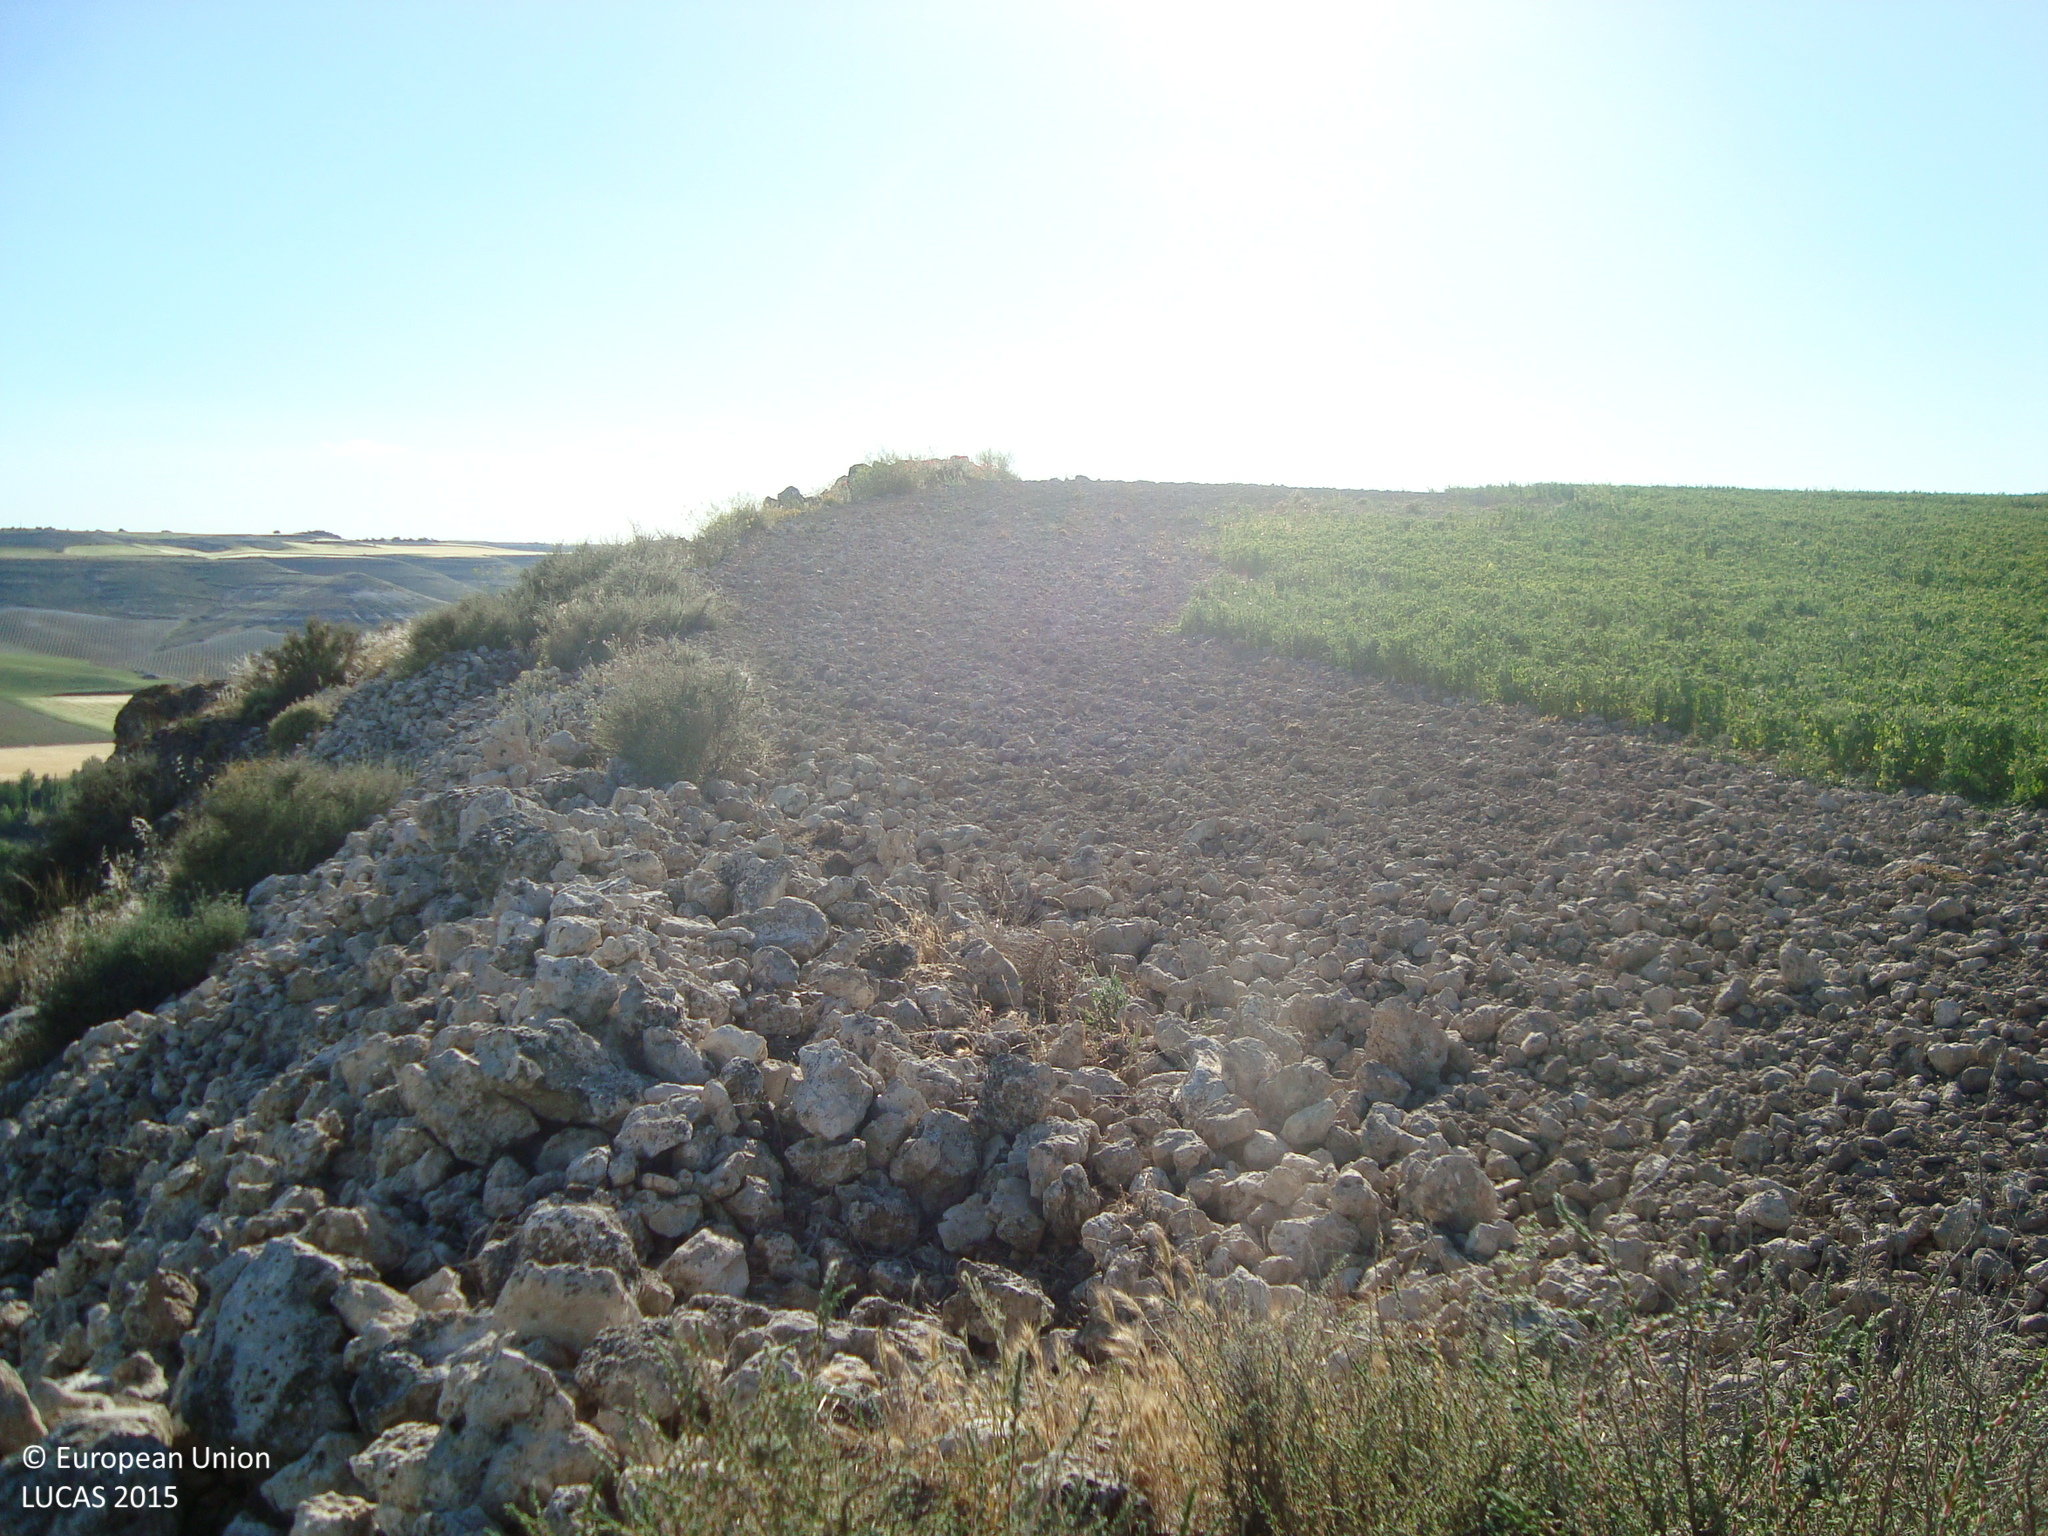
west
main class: Shrubland
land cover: Shrubland without tree cover
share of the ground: 50 - 75 %
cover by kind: shrubs 50 %, herbaceous plants 10 %
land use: Abandoned areas
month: May
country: ES
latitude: 41.5527
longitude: -4.0969
